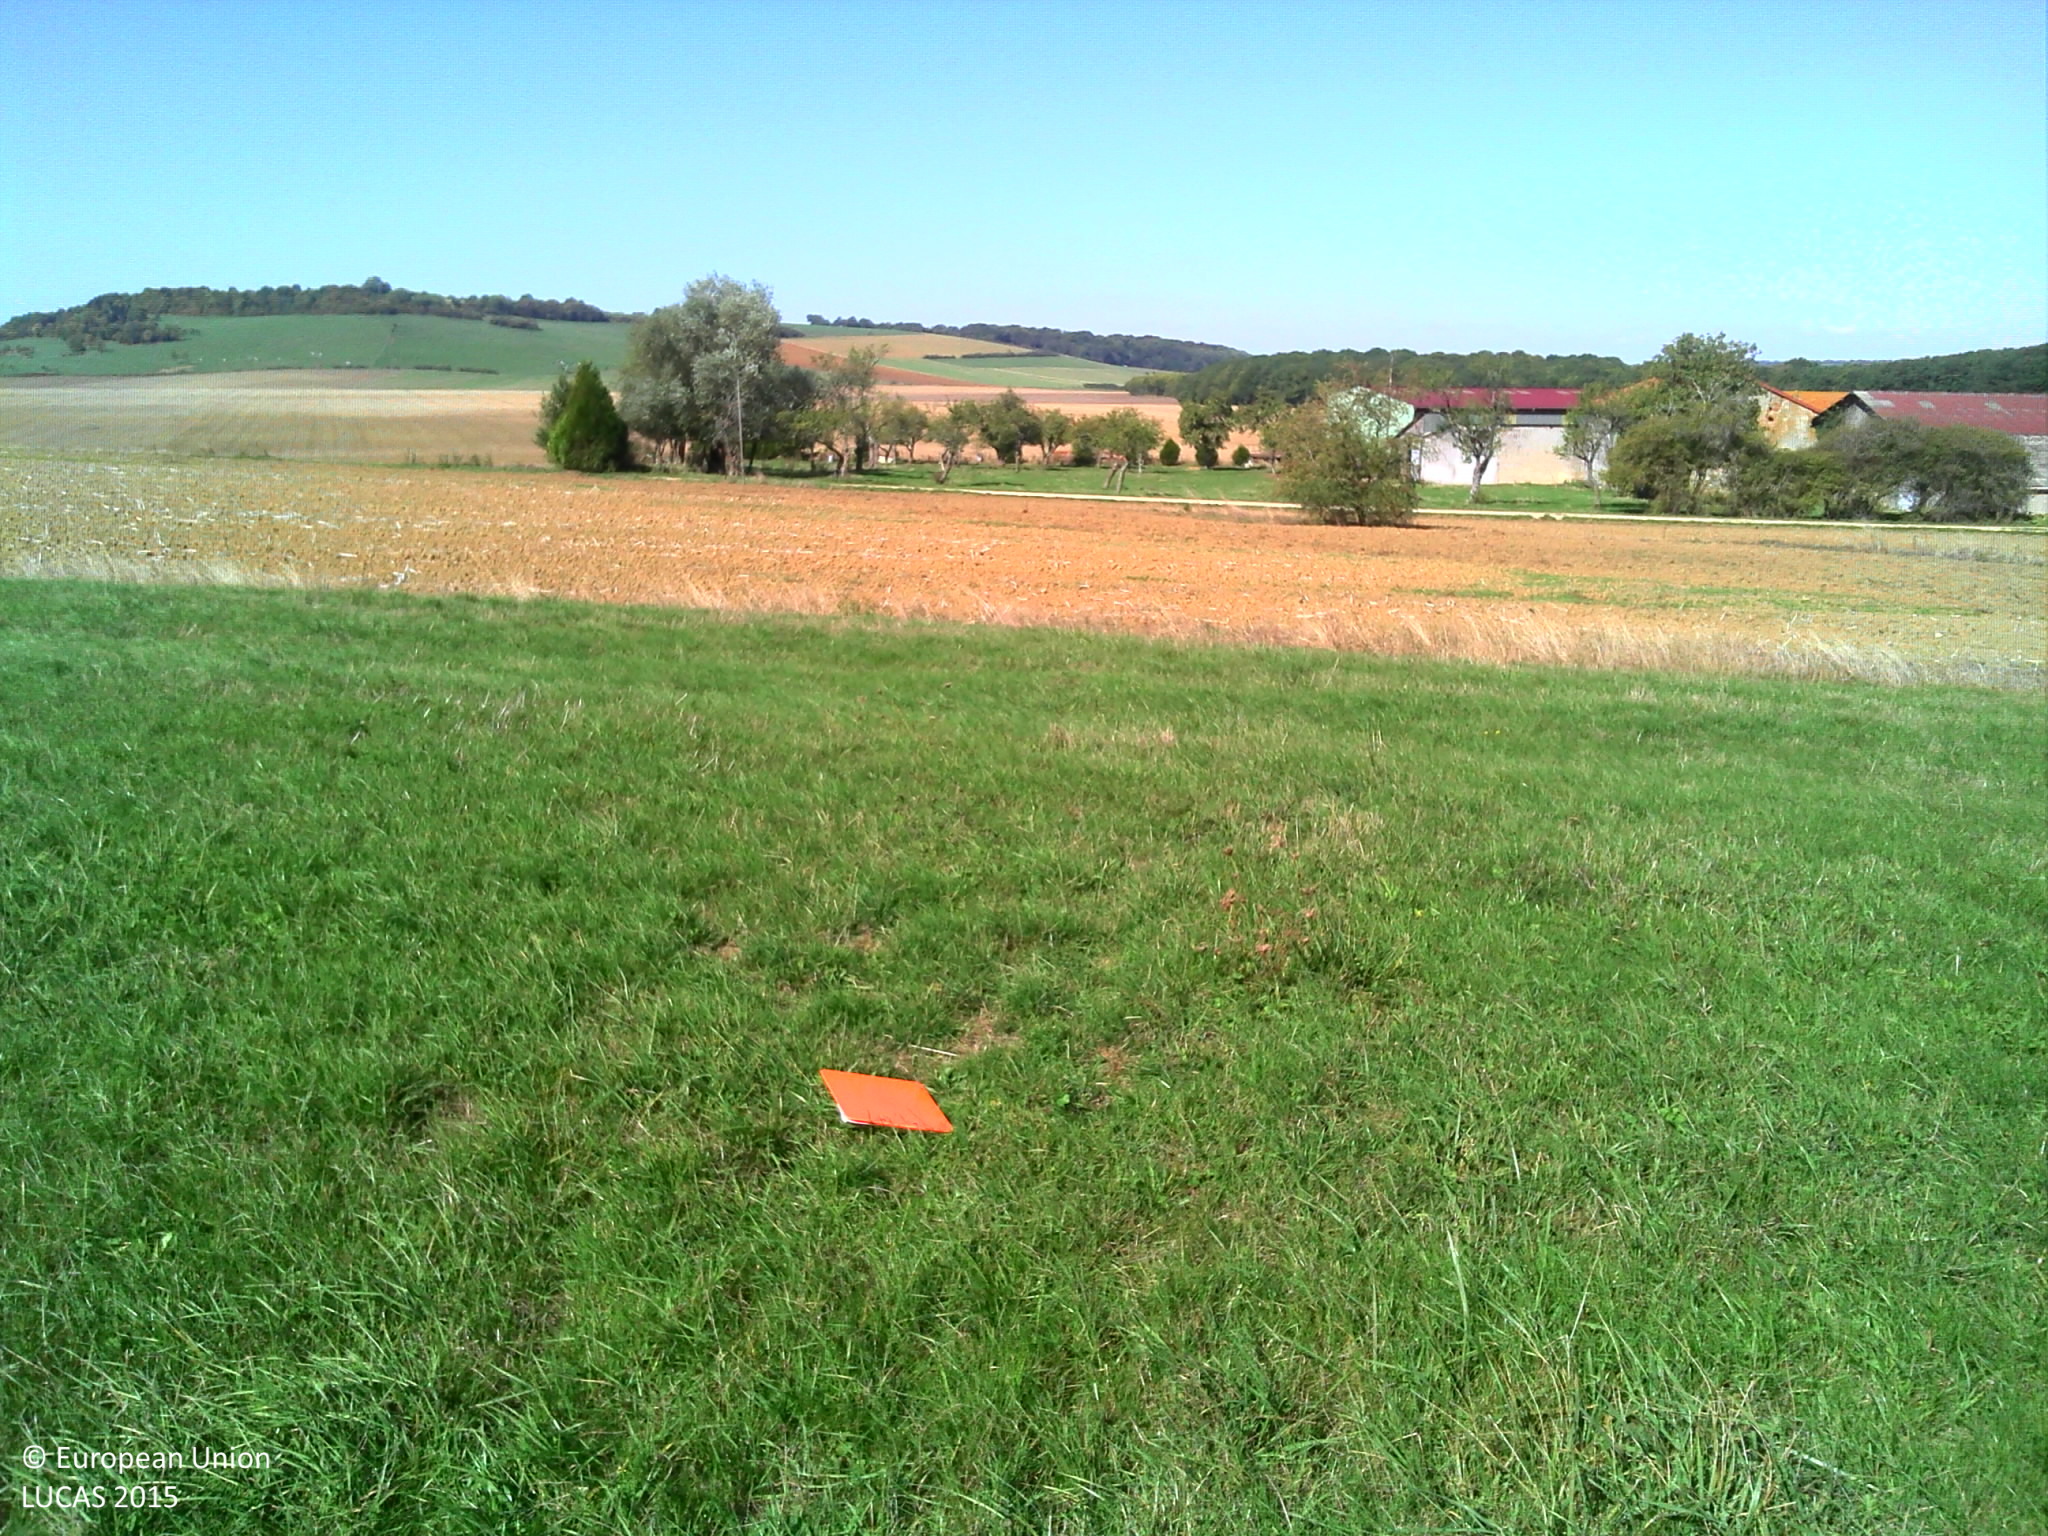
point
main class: Cropland
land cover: Temporary grasslands
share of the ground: > 75 %
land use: Agriculture (excluding fallow land and kitchen gardens)
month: September
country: FR
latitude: 48.5115
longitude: 6.0066
